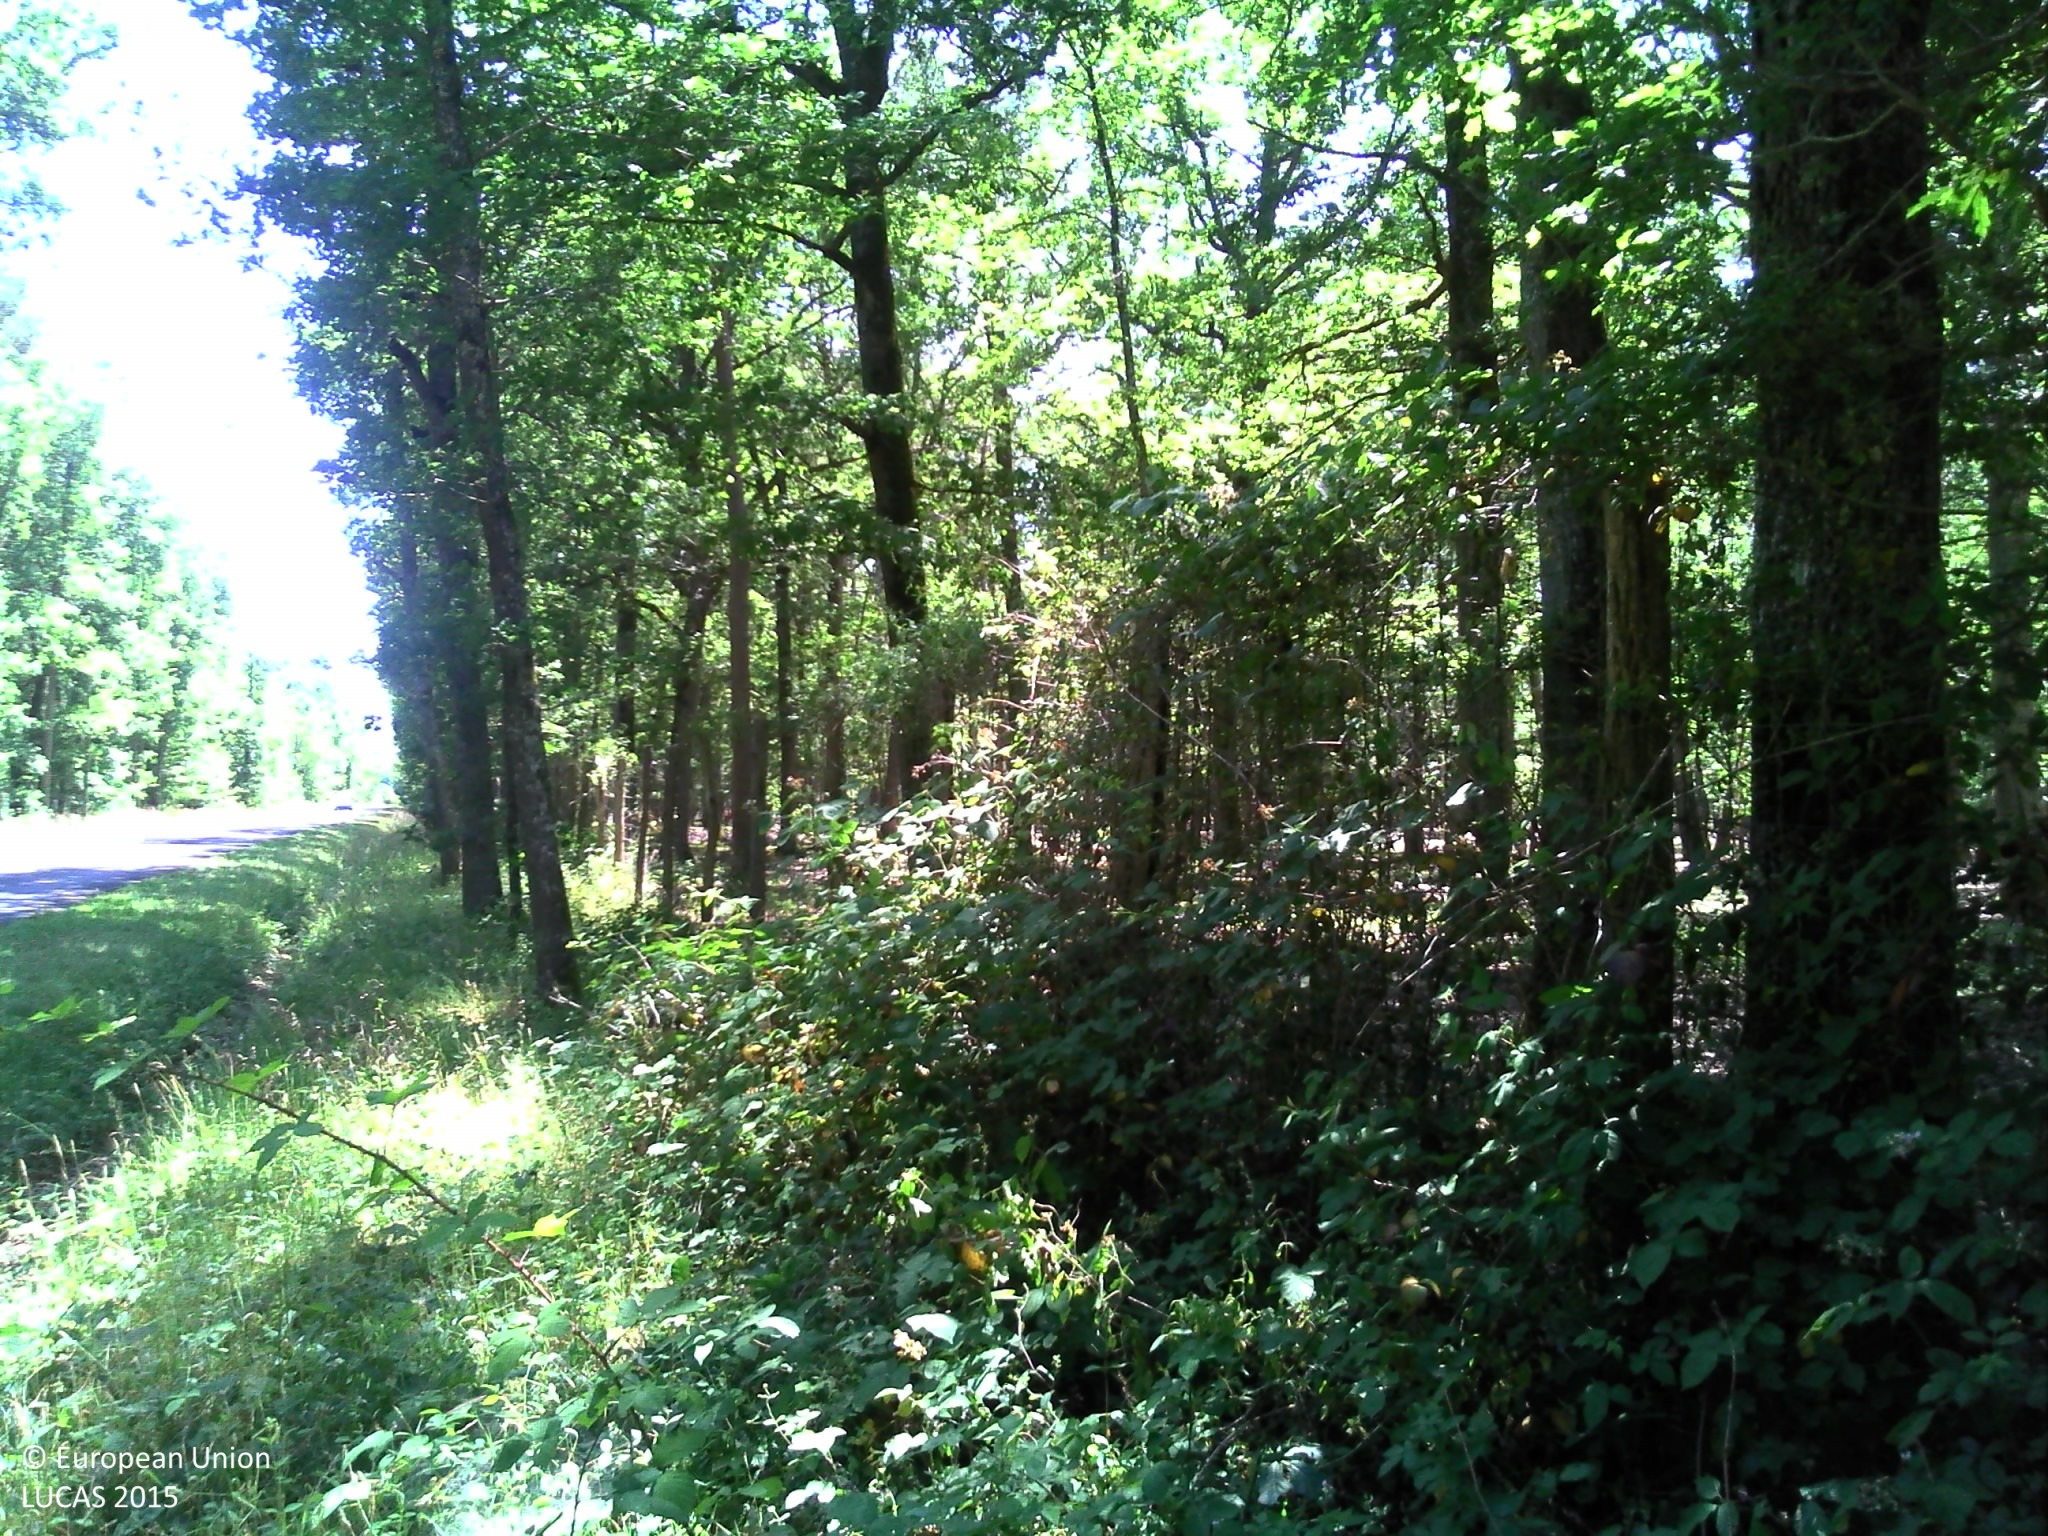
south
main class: Woodland
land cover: Pine dominated mixed woodland
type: acidophilous oak and oak-birch forest
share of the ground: > 75 %
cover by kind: coniferous forest trees 75 %, broadleaved forest trees 25 %
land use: Forestry
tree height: > 5 m
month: June
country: FR
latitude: 47.7588
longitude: 2.6144
